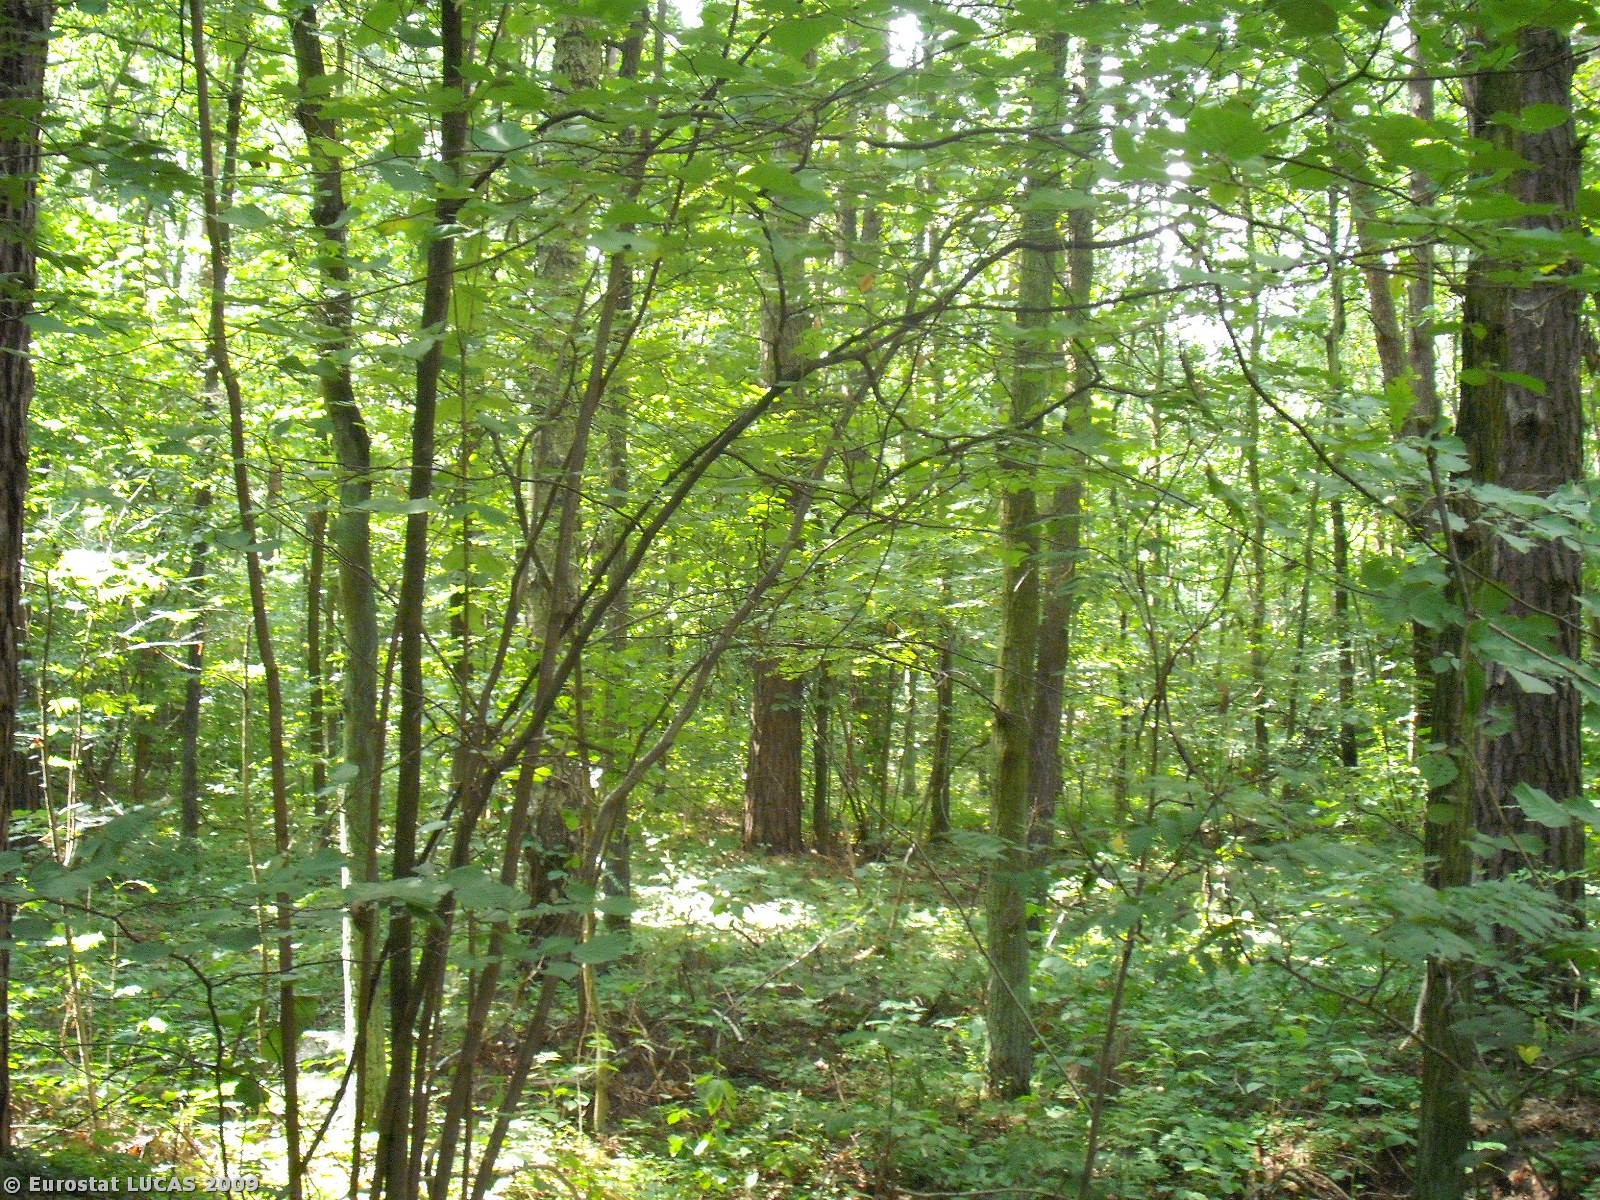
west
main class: Woodland
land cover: Mixed woodland
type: hemiboreal forest and nemoral coniferous forest and mixed broadleaved-coniferous forest
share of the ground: > 75 %
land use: Forestry
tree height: > 5 m
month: August
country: PL
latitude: 51.8111
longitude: 21.5542
